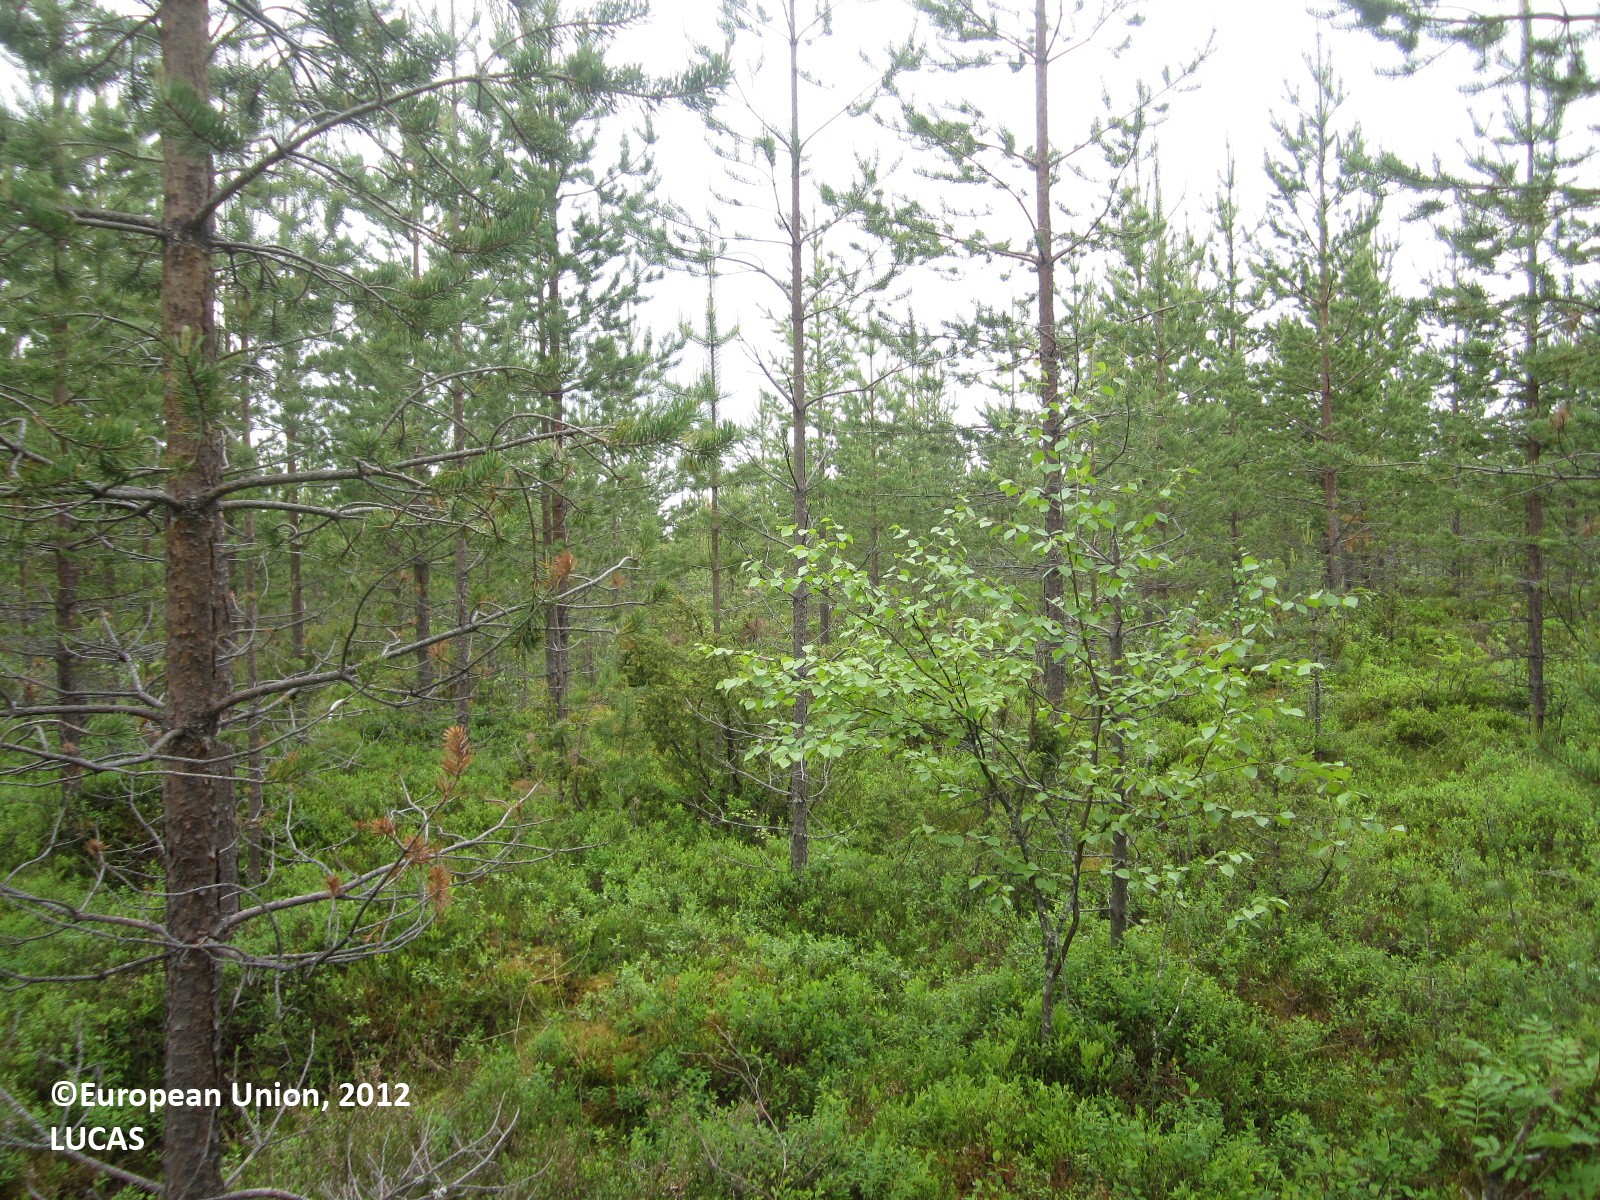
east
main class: Woodland
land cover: Pine dominated coniferous woodland
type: boreal forest
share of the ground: 25 - 50 %
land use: Forestry
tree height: > 5 m
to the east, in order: Pine dominated coniferous woodland; Ditches and canals; Abandoned hedges; Paved roads, cycling and walking lanes; Abandoned hedges; Ditches and canals; Pine dominated mixed woodland
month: June
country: FI
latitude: 64.7253
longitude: 29.9389
